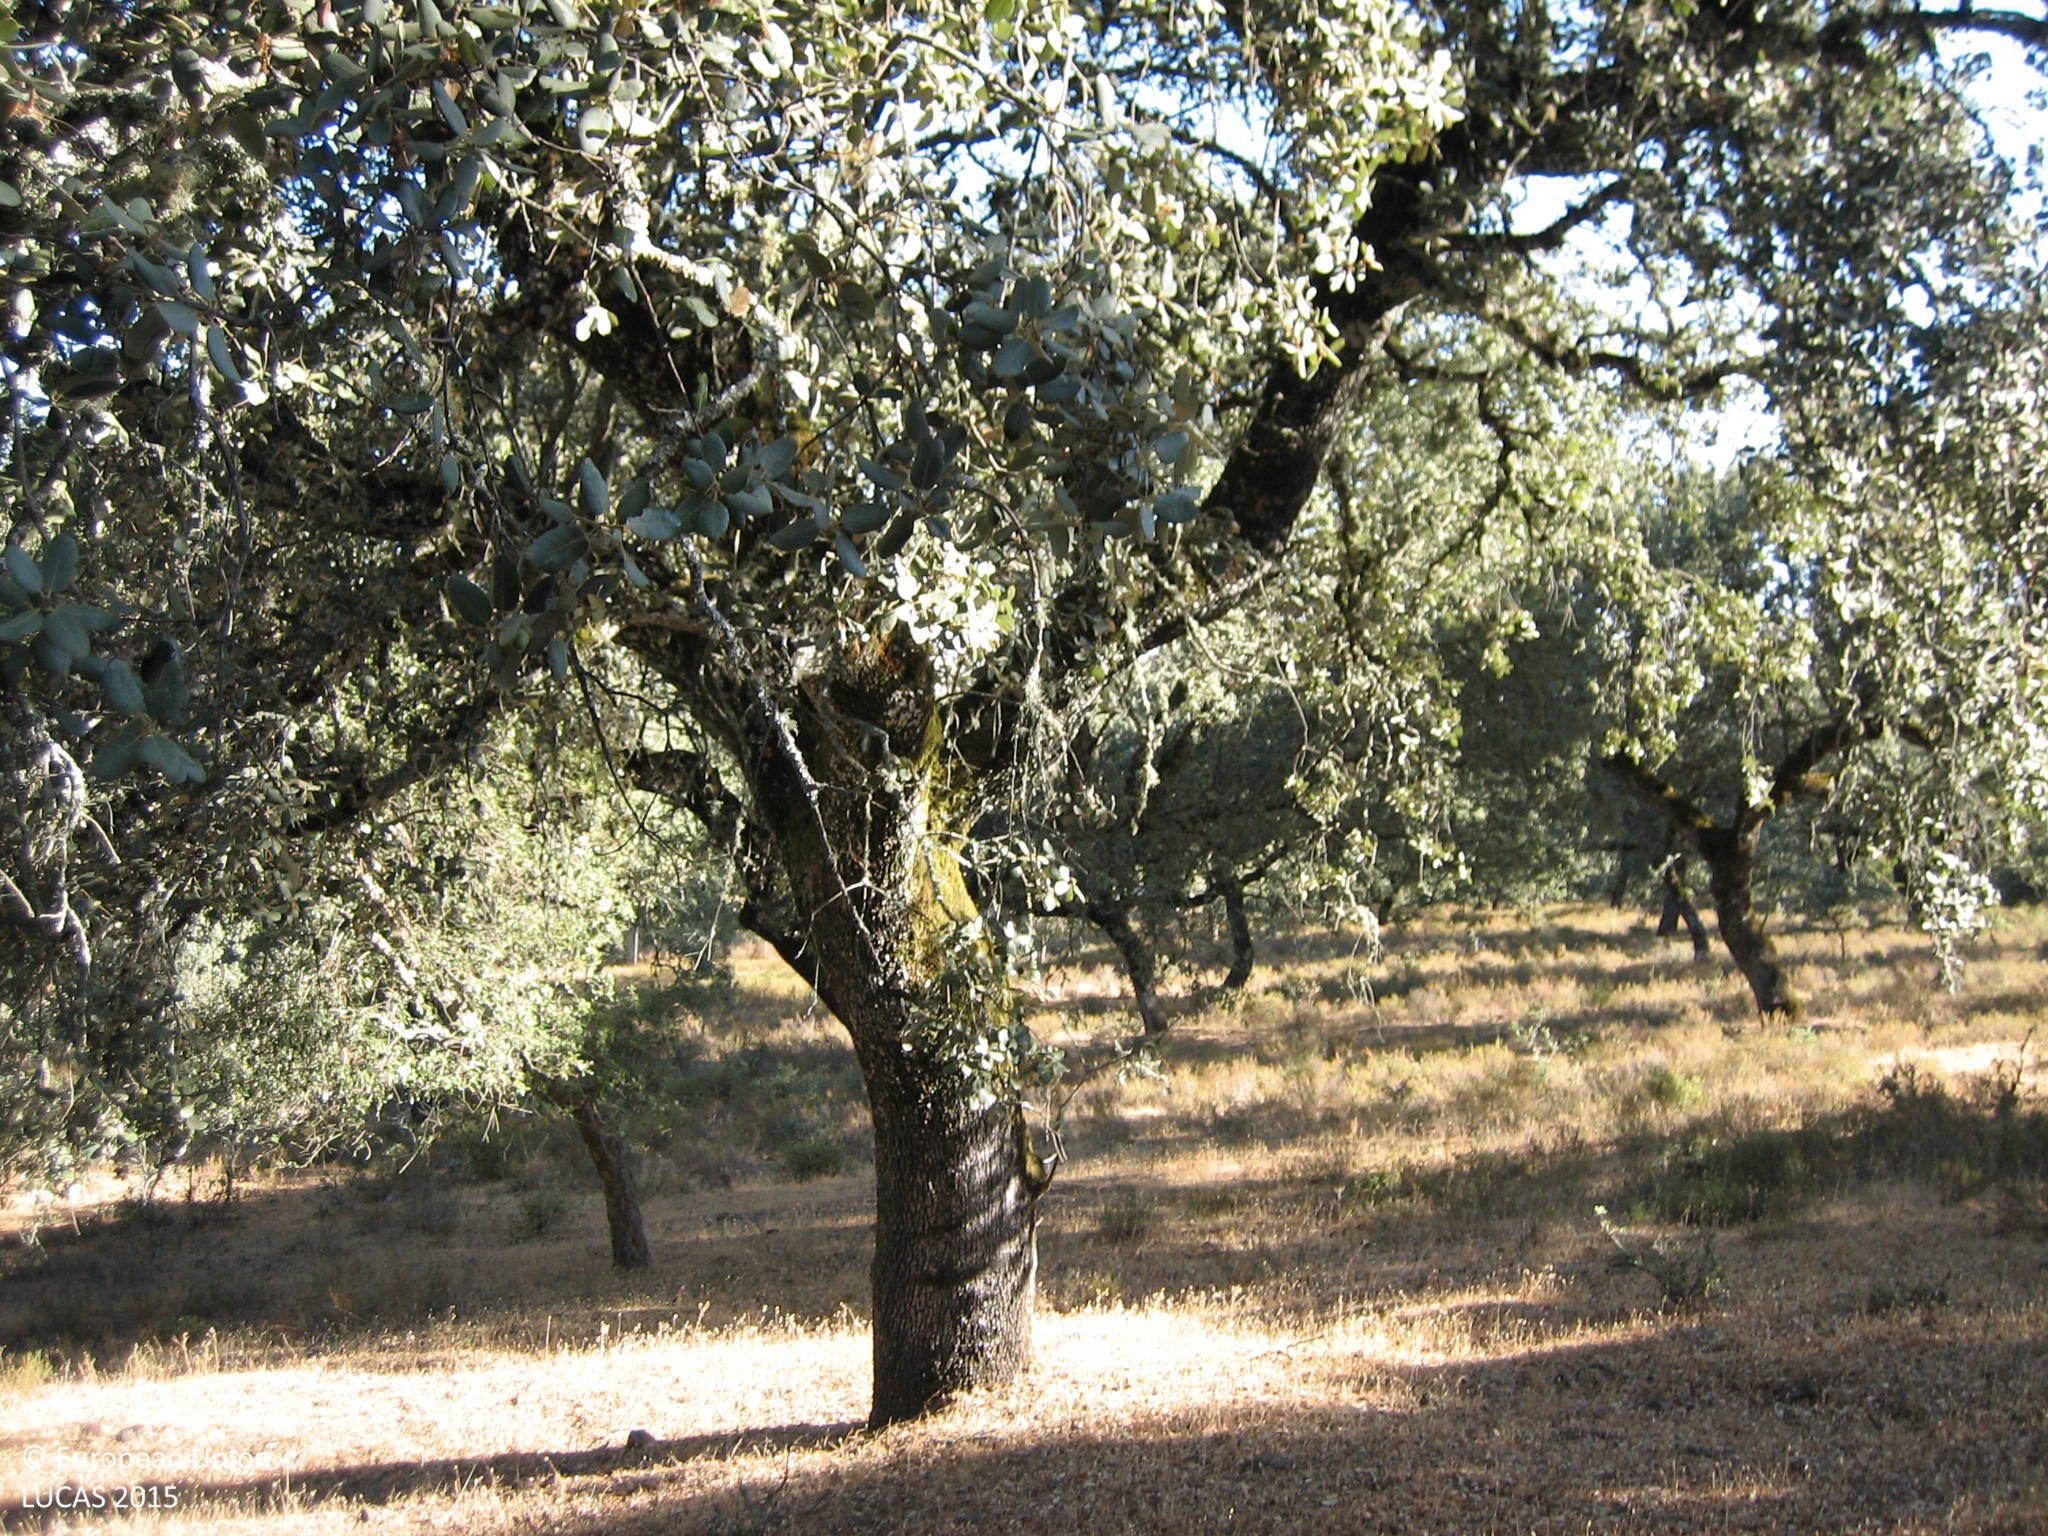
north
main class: Woodland
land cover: Broadleaved woodland
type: broadleaved evergreen forest
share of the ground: 50 - 75 %
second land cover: Shrubland without tree cover
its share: 25 - 50 %
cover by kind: broadleaved forest trees 60 %, shrubs 30 %, herbaceous plants 10 %
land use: Forestry
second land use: Agriculture (excluding fallow land and kitchen gardens)
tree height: > 5 m
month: August
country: ES
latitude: 38.0851
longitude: -6.2885
